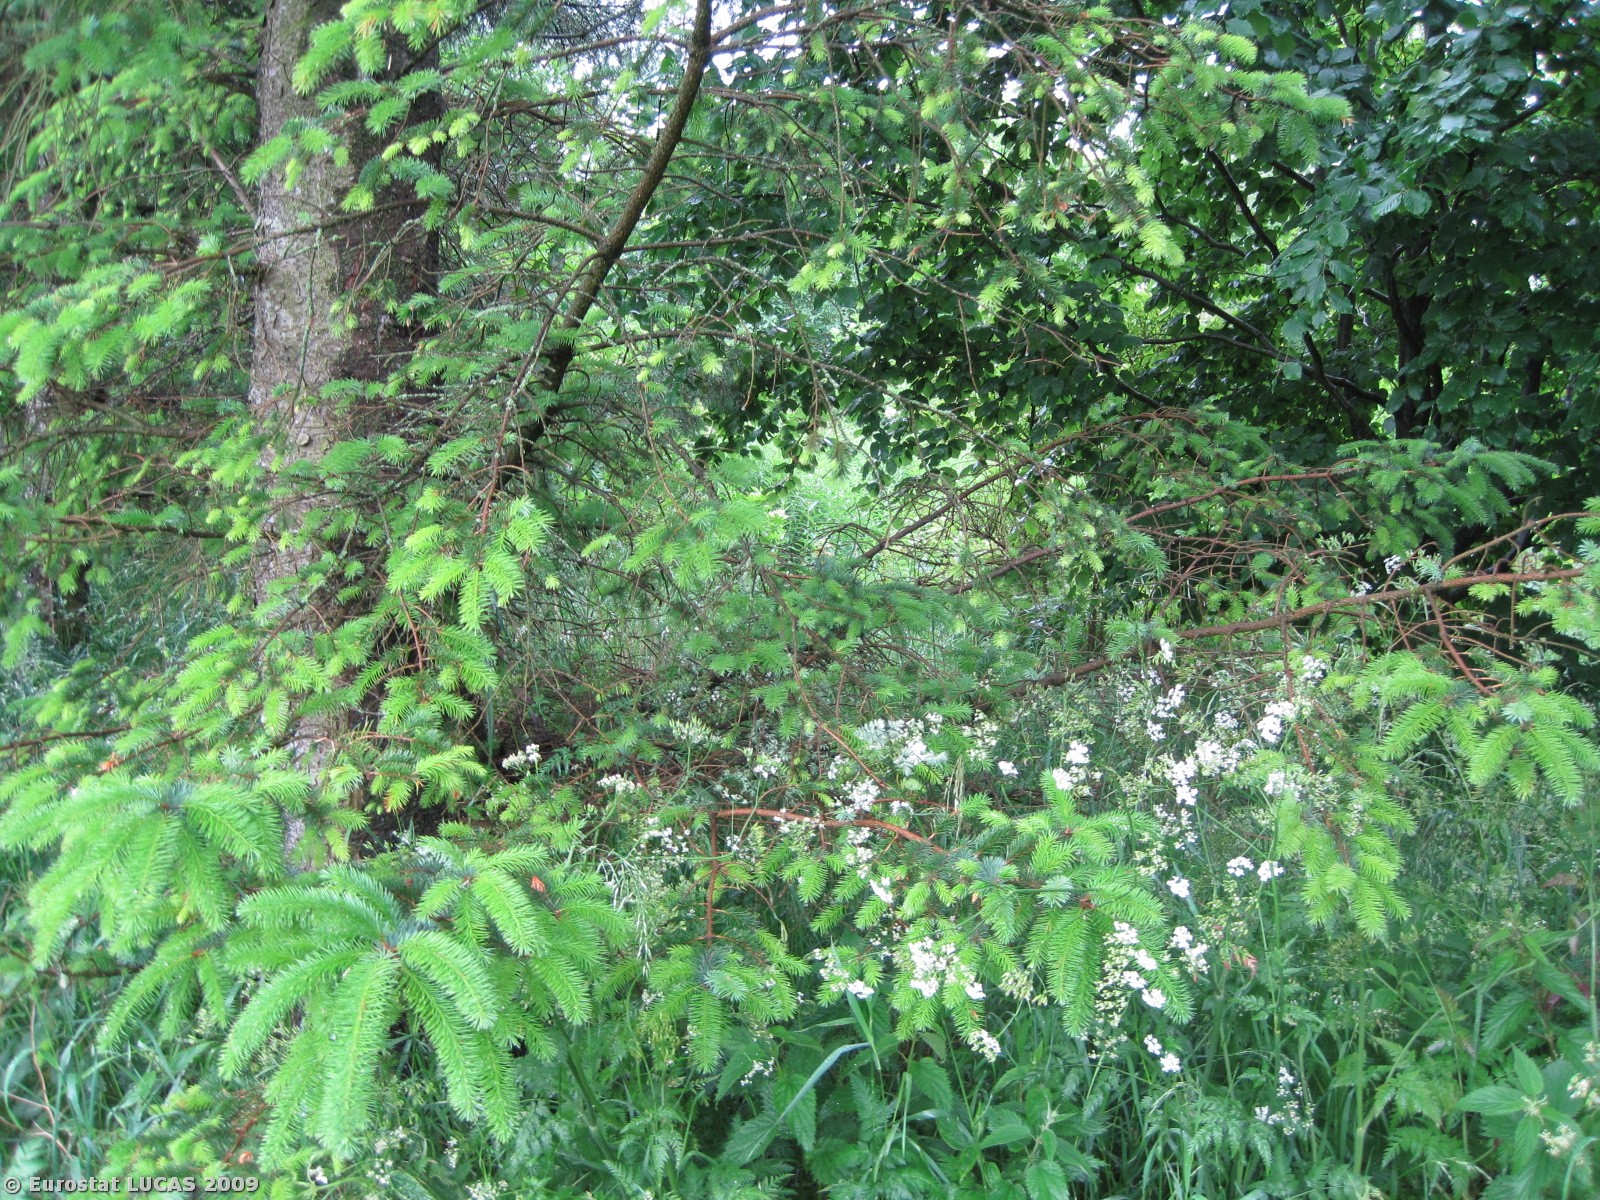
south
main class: Woodland
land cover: Mixed woodland
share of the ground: > 75 %
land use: Unused
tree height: > 5 m
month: June
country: DK
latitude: 57.5179
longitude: 10.2500
